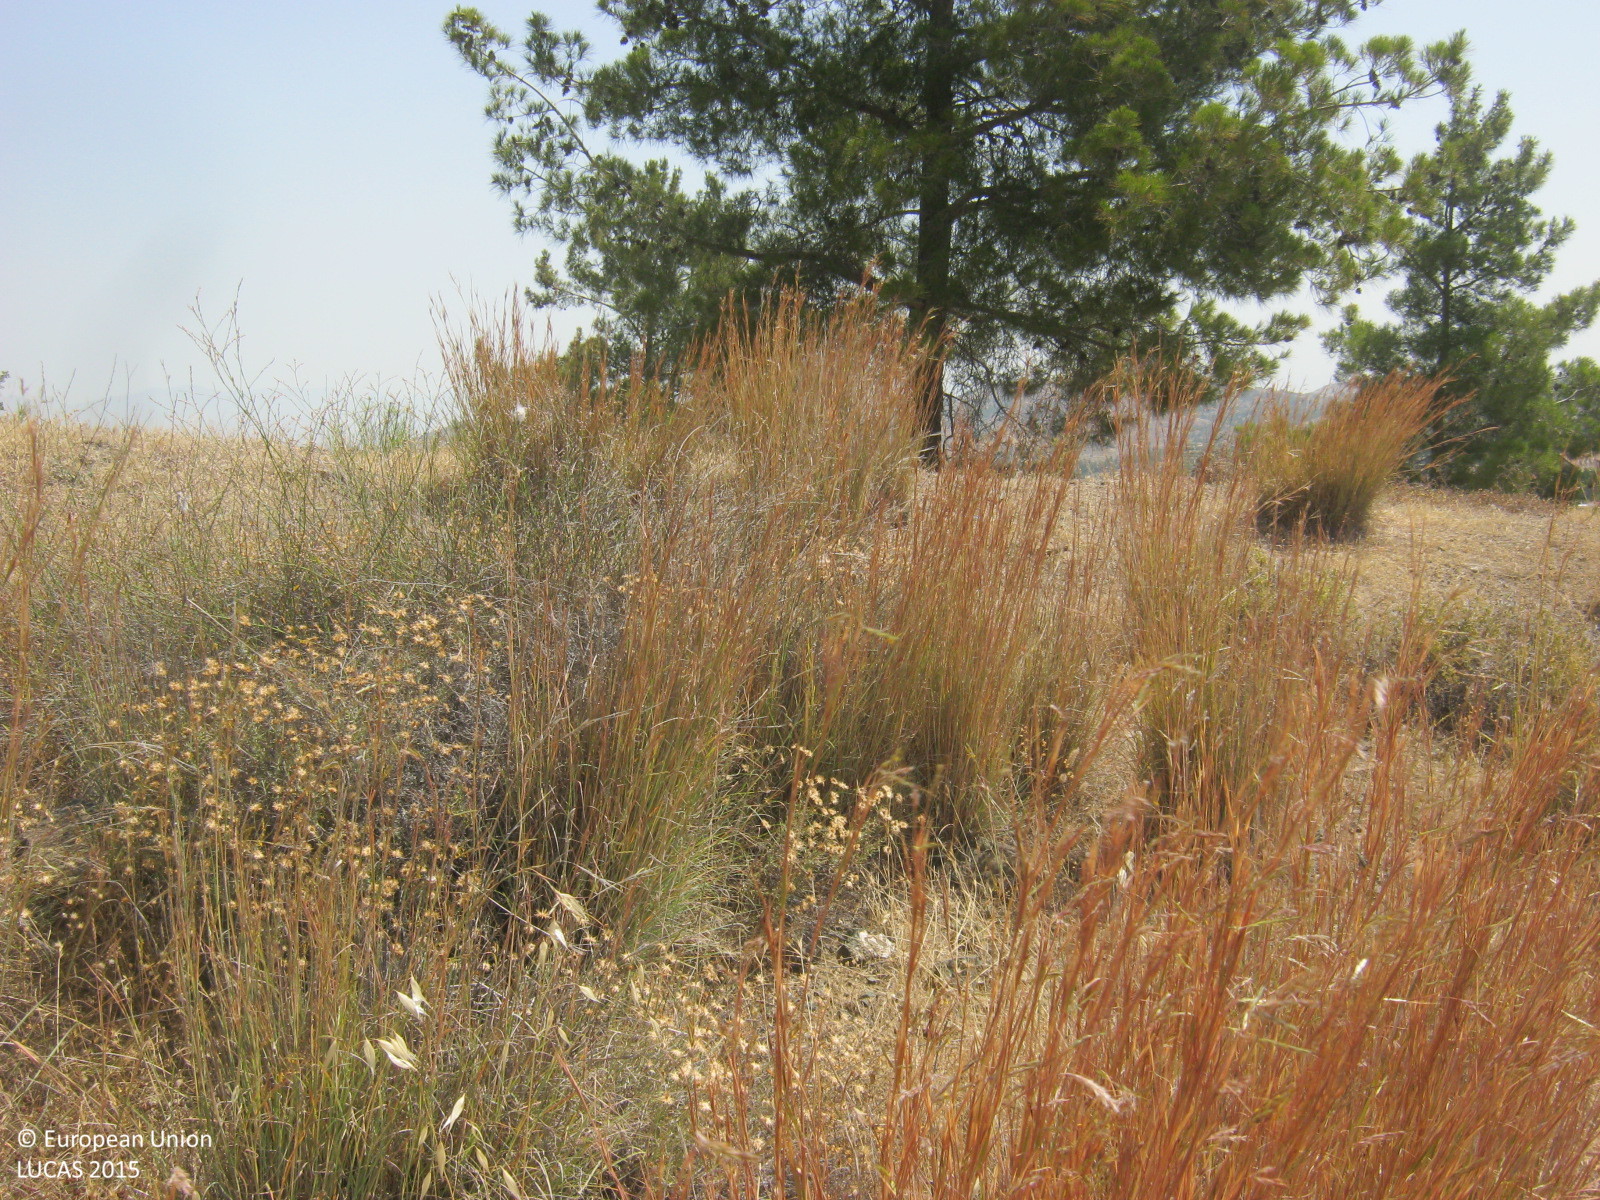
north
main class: Shrubland
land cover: Shrubland without tree cover
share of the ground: 10 - 25 %
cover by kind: herbaceous plants 70 %, shrubs 25 %, unconsolidated bare surface 5 %
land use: Semi-natural and natural areas not in use
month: June
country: CY
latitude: 35.0357
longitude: 33.0082
